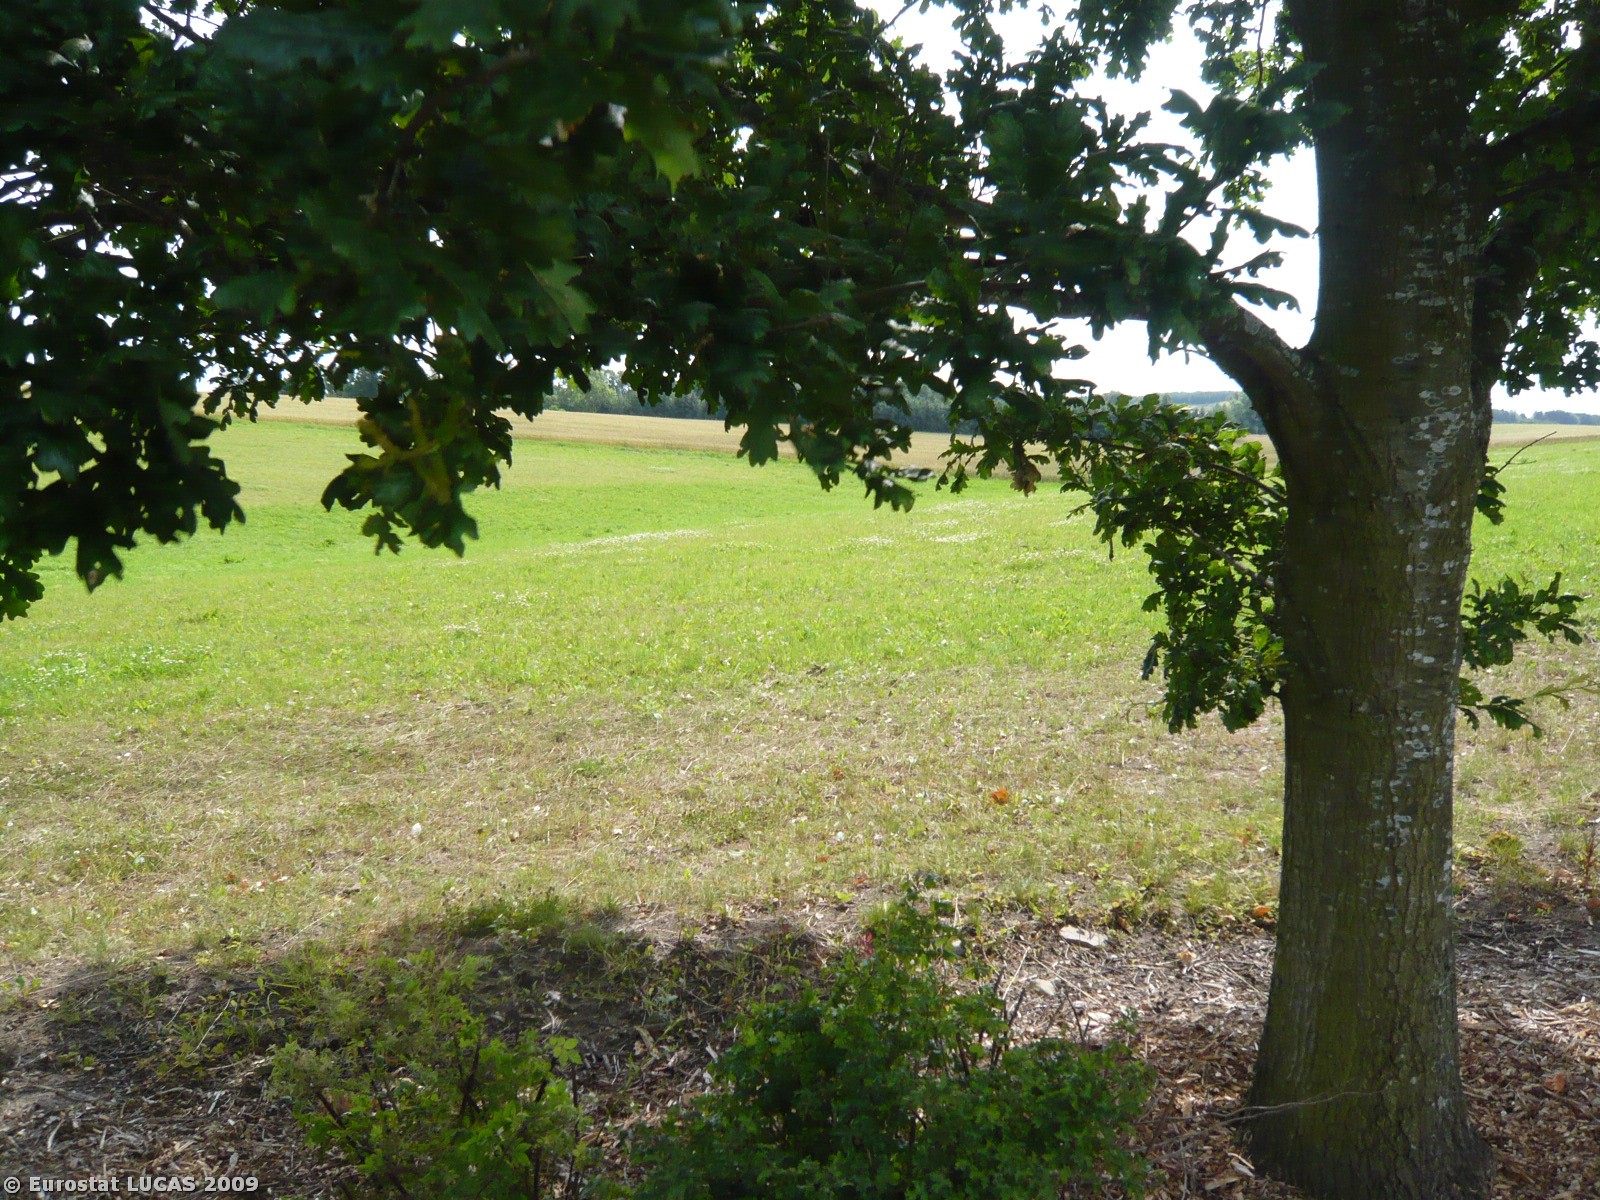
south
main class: Cropland
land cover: Common wheat
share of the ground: > 75 %
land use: Agriculture (excluding fallow land and kitchen gardens)
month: July
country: DK
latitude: 55.5640
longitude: 11.7902
